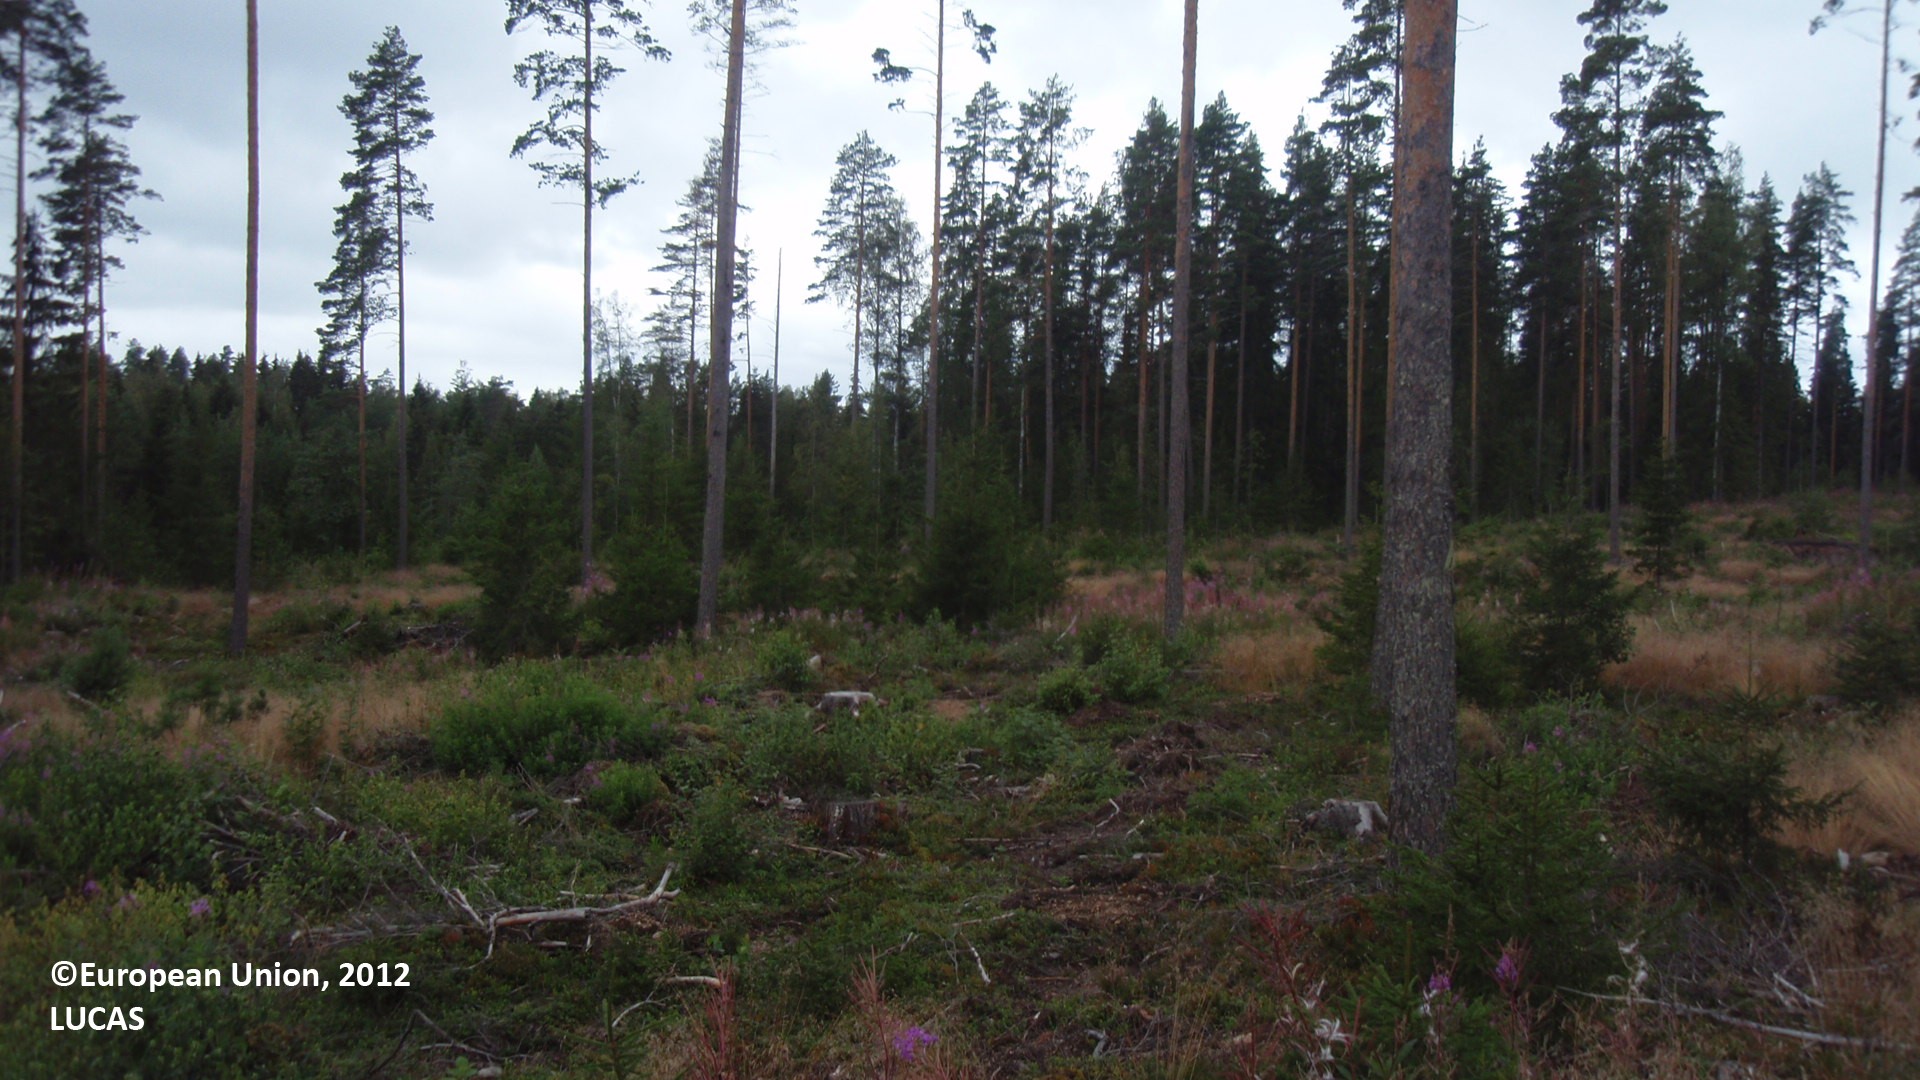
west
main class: Woodland
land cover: Other coniferous woodland
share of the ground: 10 - 25 %
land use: Forestry
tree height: < 5 m
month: August
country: FI
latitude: 61.0632
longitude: 27.5818
